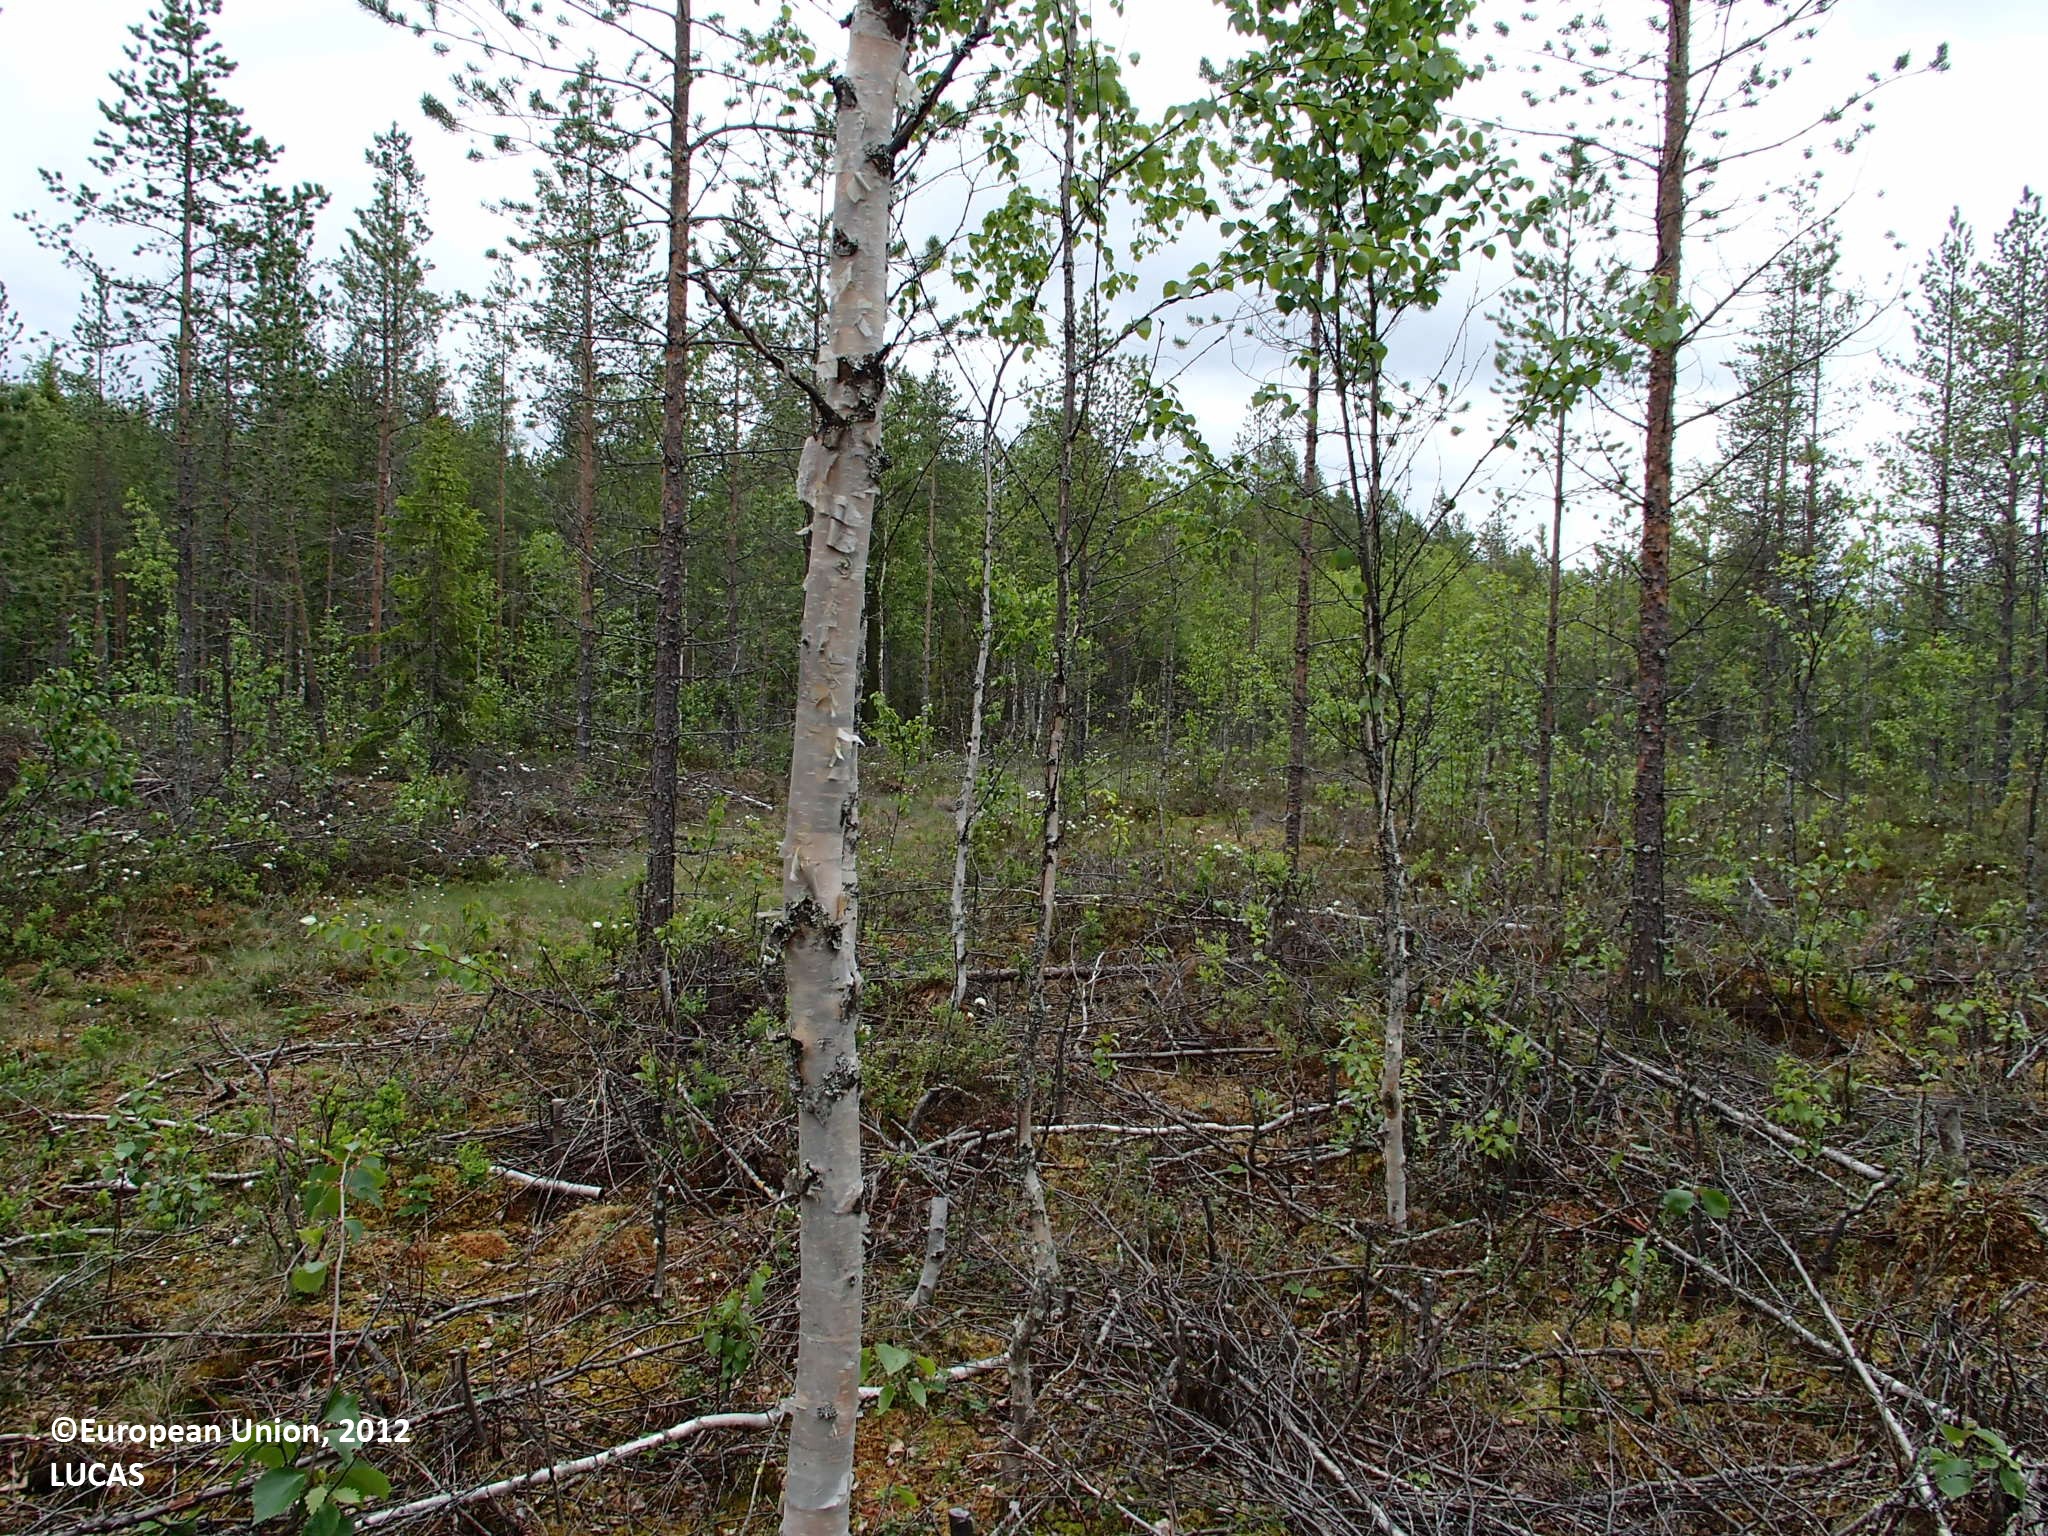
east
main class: Woodland
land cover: Pine dominated mixed woodland
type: boreal forest
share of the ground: 25 - 50 %
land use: Forestry
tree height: > 5 m
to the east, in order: Pine dominated mixed woodland; Broadleaved woodland; Other mixed woodland; Tracks; Pine dominated mixed woodland; Ditches and canals; Pine dominated mixed woodland; Spontaneously vegetated surfaces; Pine dominated mixed woodland; Ditches and canals; Pine dominated mixed woodland
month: June
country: FI
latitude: 66.4955
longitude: 27.2517
